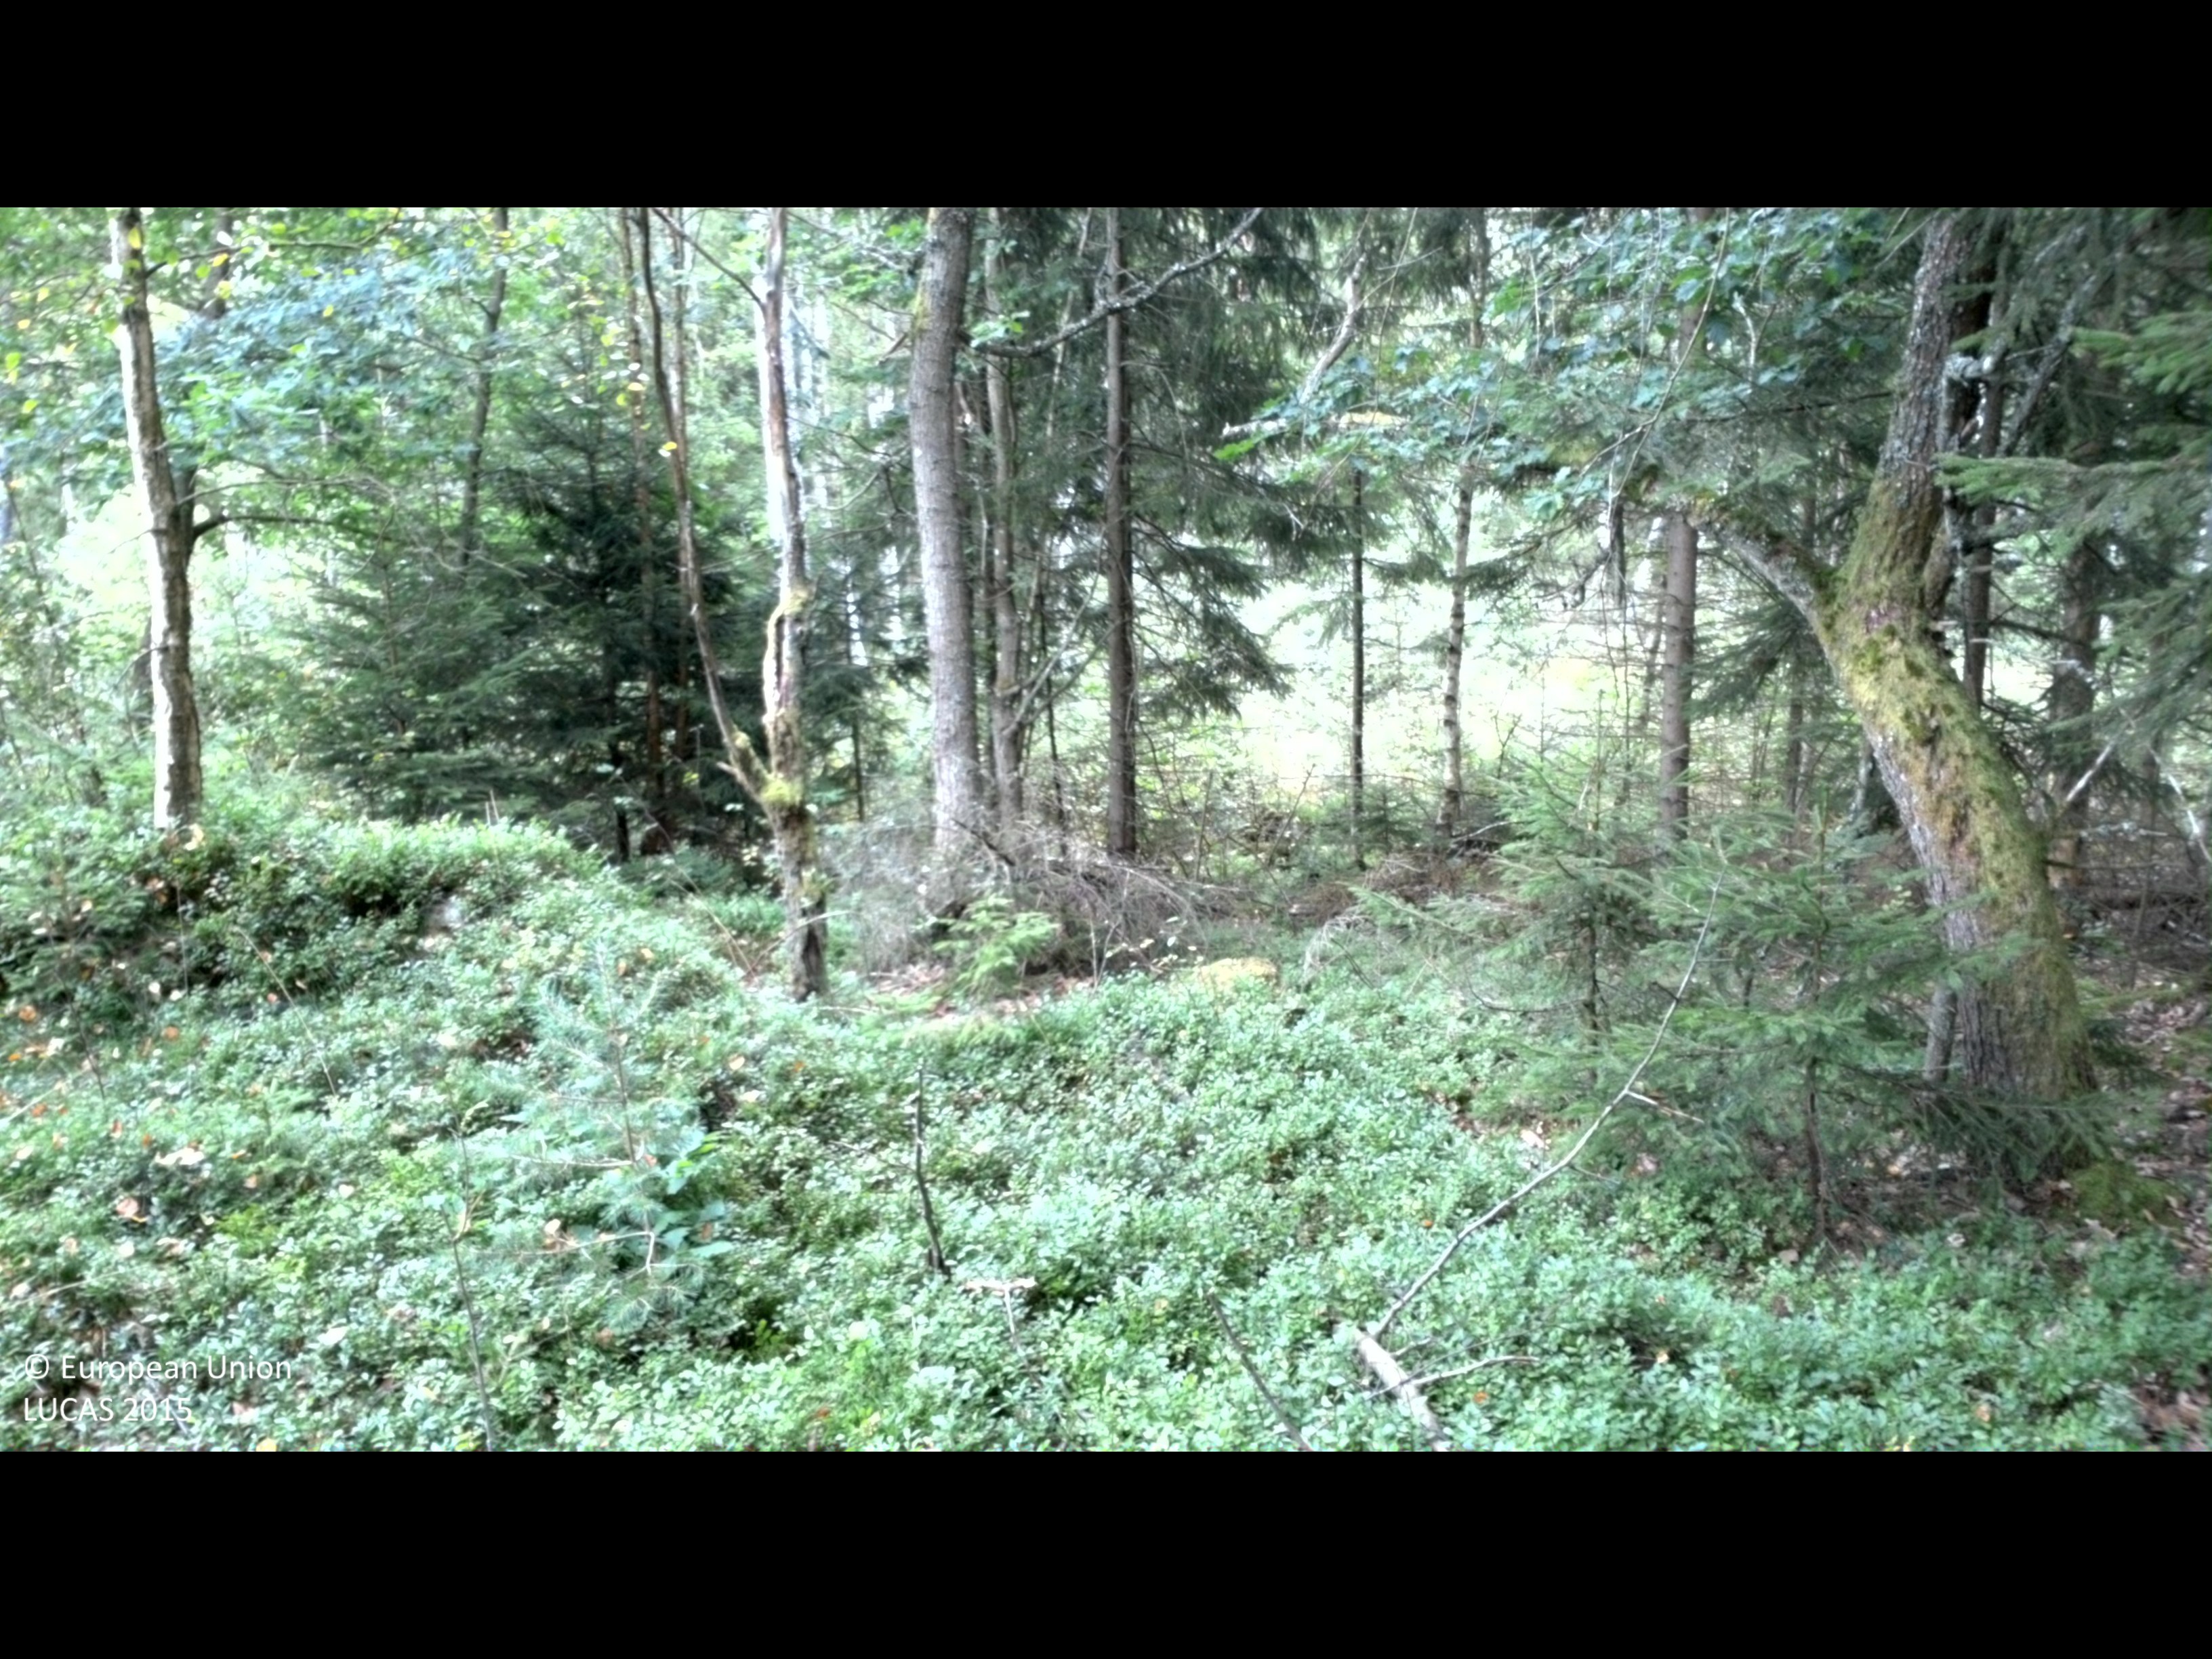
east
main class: Woodland
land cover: Spruce dominated mixed woodland
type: boreal forest
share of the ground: 50 - 75 %
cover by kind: coniferous forest trees 50 %, broadleaved forest trees 20 %, shrubs 15 %, lichens and mosses 15 %
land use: Forestry
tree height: > 5 m
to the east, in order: Spruce dominated mixed woodland; Grass margins; Paved roads, cycling and walking lanes; Grass margins; Spruce dominated mixed woodland; Ditches and canals; Spruce dominated mixed woodland; Broadleaved woodland
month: August
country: SE
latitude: 56.3334
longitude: 14.2514
